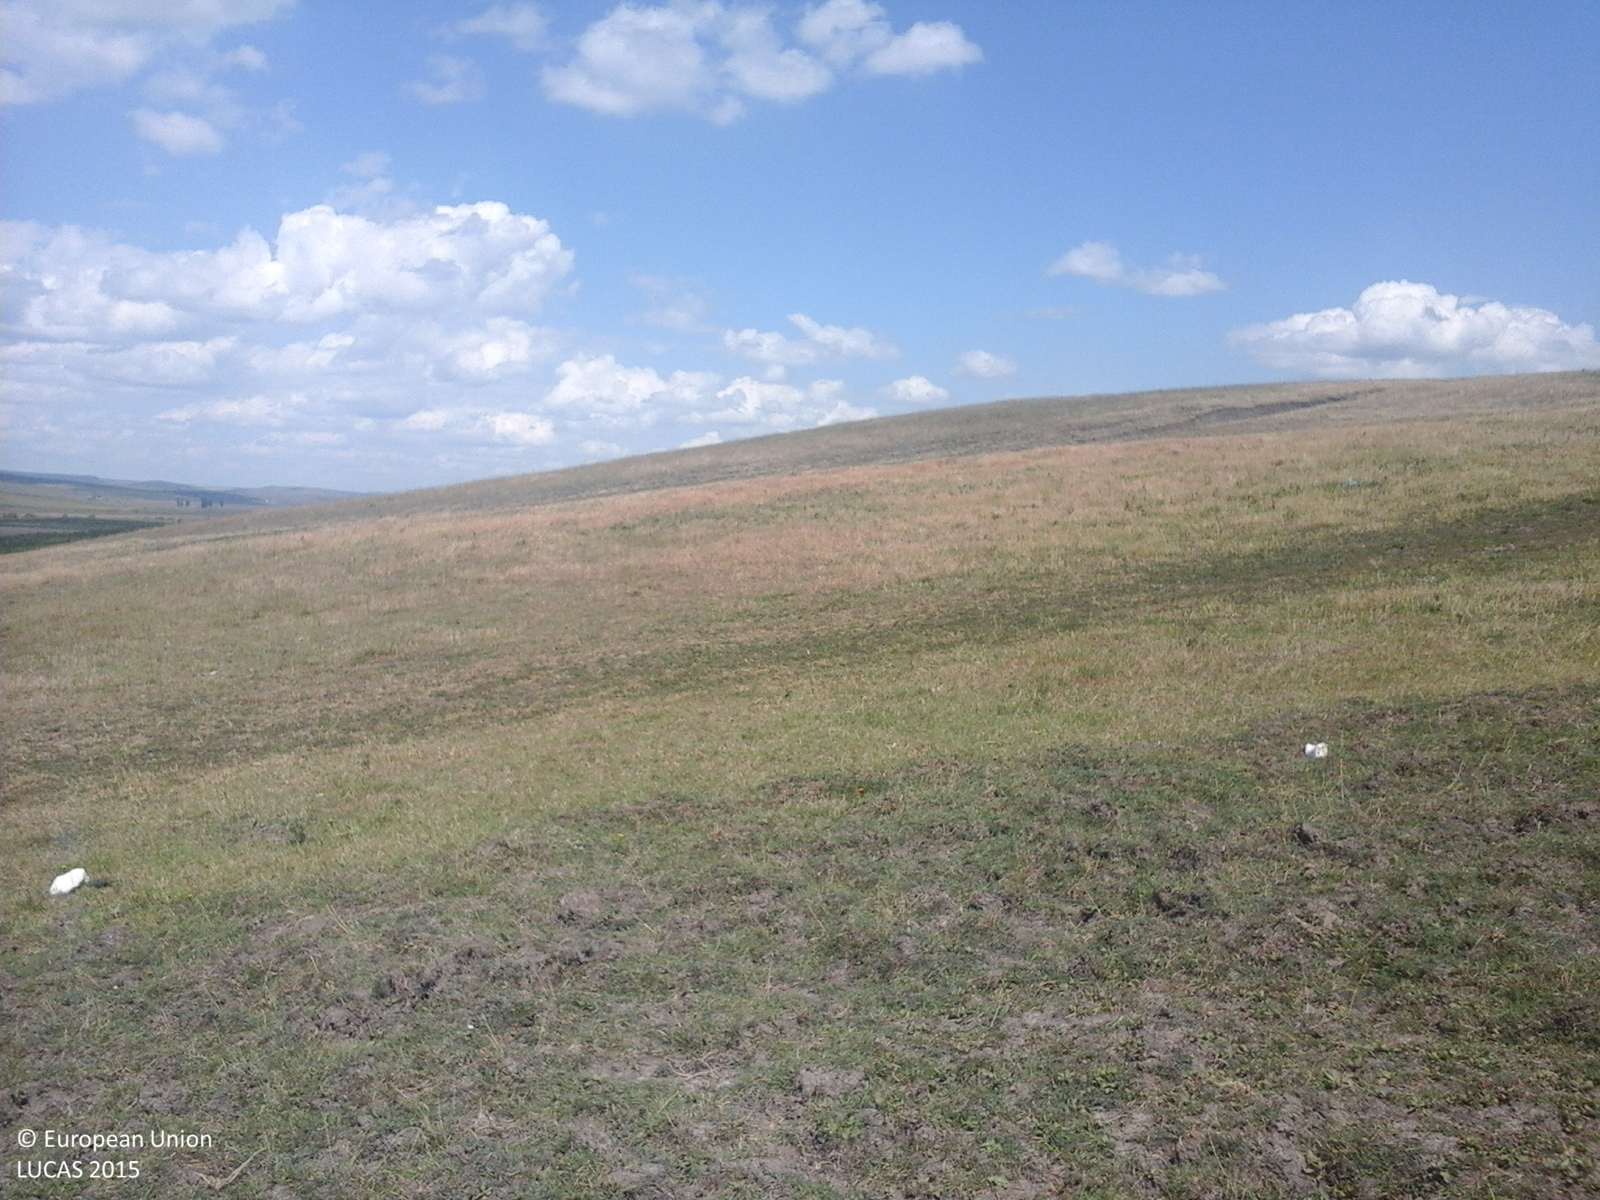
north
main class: Grassland
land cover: Grassland without tree/shrub cover
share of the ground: > 75 %
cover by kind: herbaceous plants 100 %
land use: Agriculture (excluding fallow land and kitchen gardens)
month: July
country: RO
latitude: 46.5312
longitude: 27.8398
